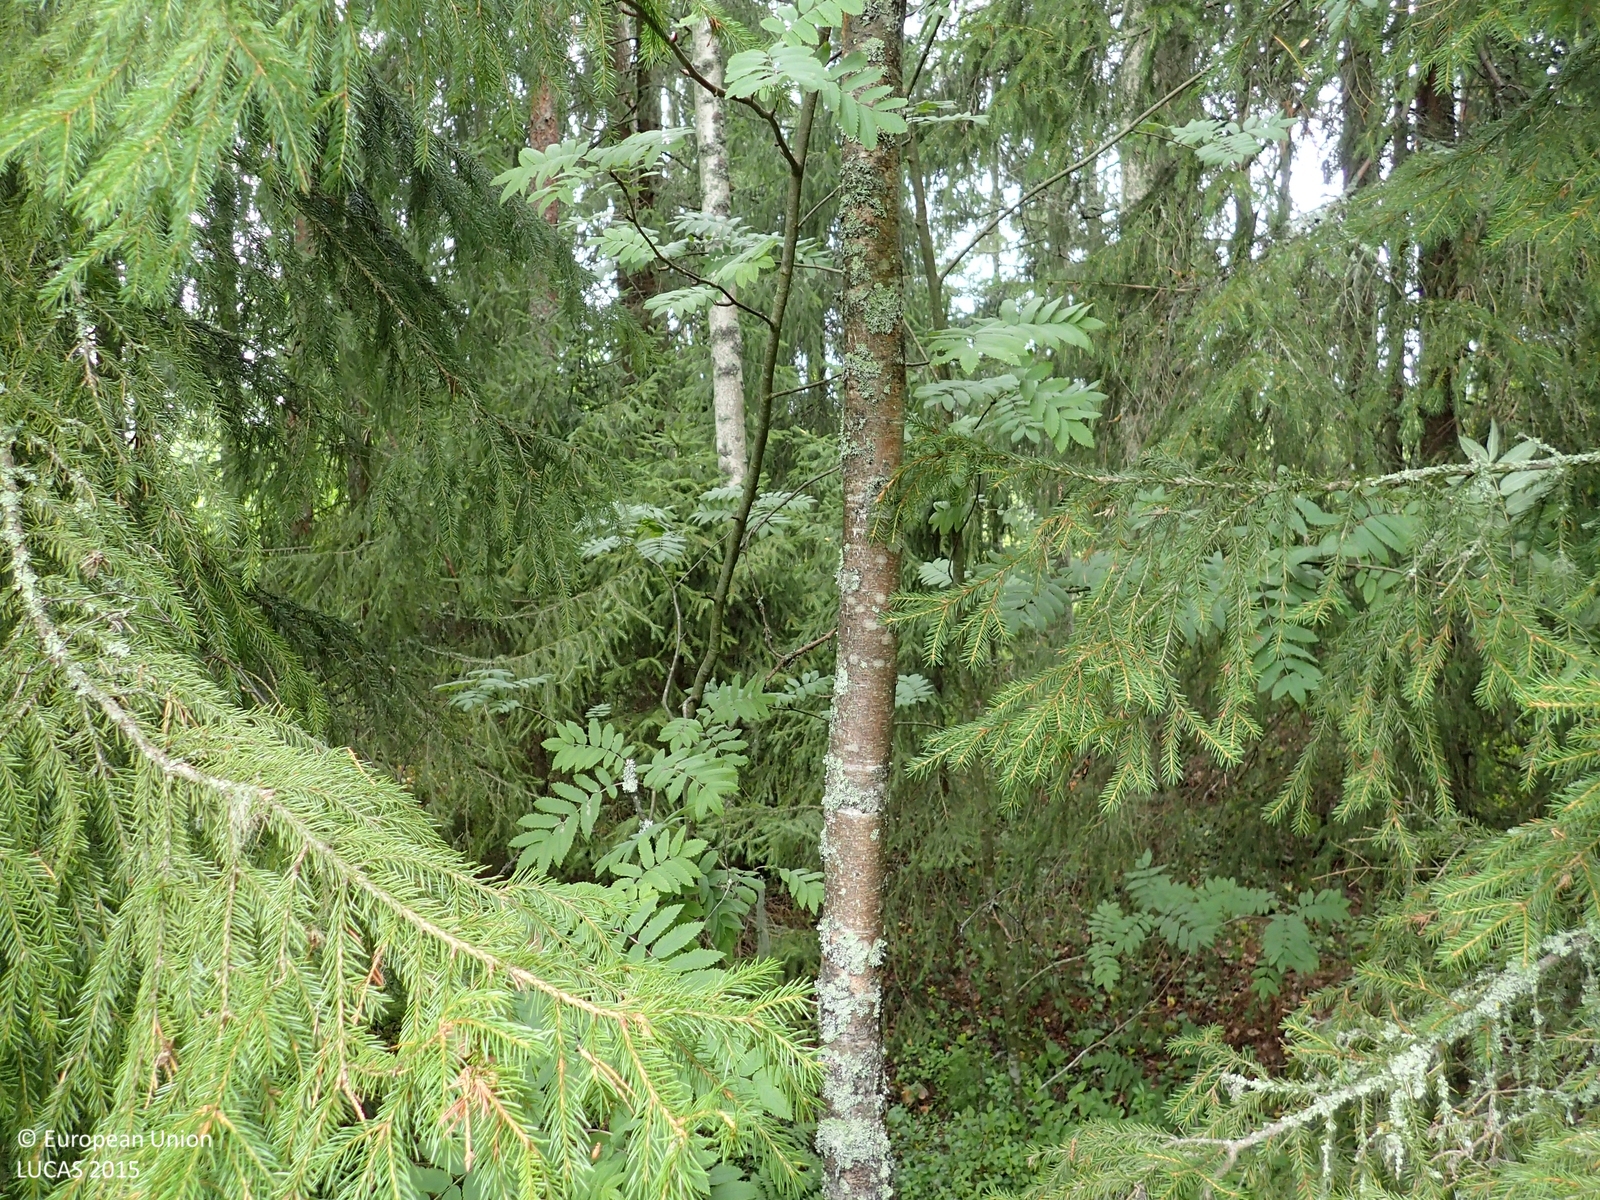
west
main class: Woodland
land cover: Other mixed woodland
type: boreal forest
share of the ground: > 75 %
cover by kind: coniferous forest trees 60 %, broadleaved forest trees 20 %, shrubs 20 %
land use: Forestry
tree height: > 5 m
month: August
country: FI
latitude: 62.9169
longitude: 21.9963
